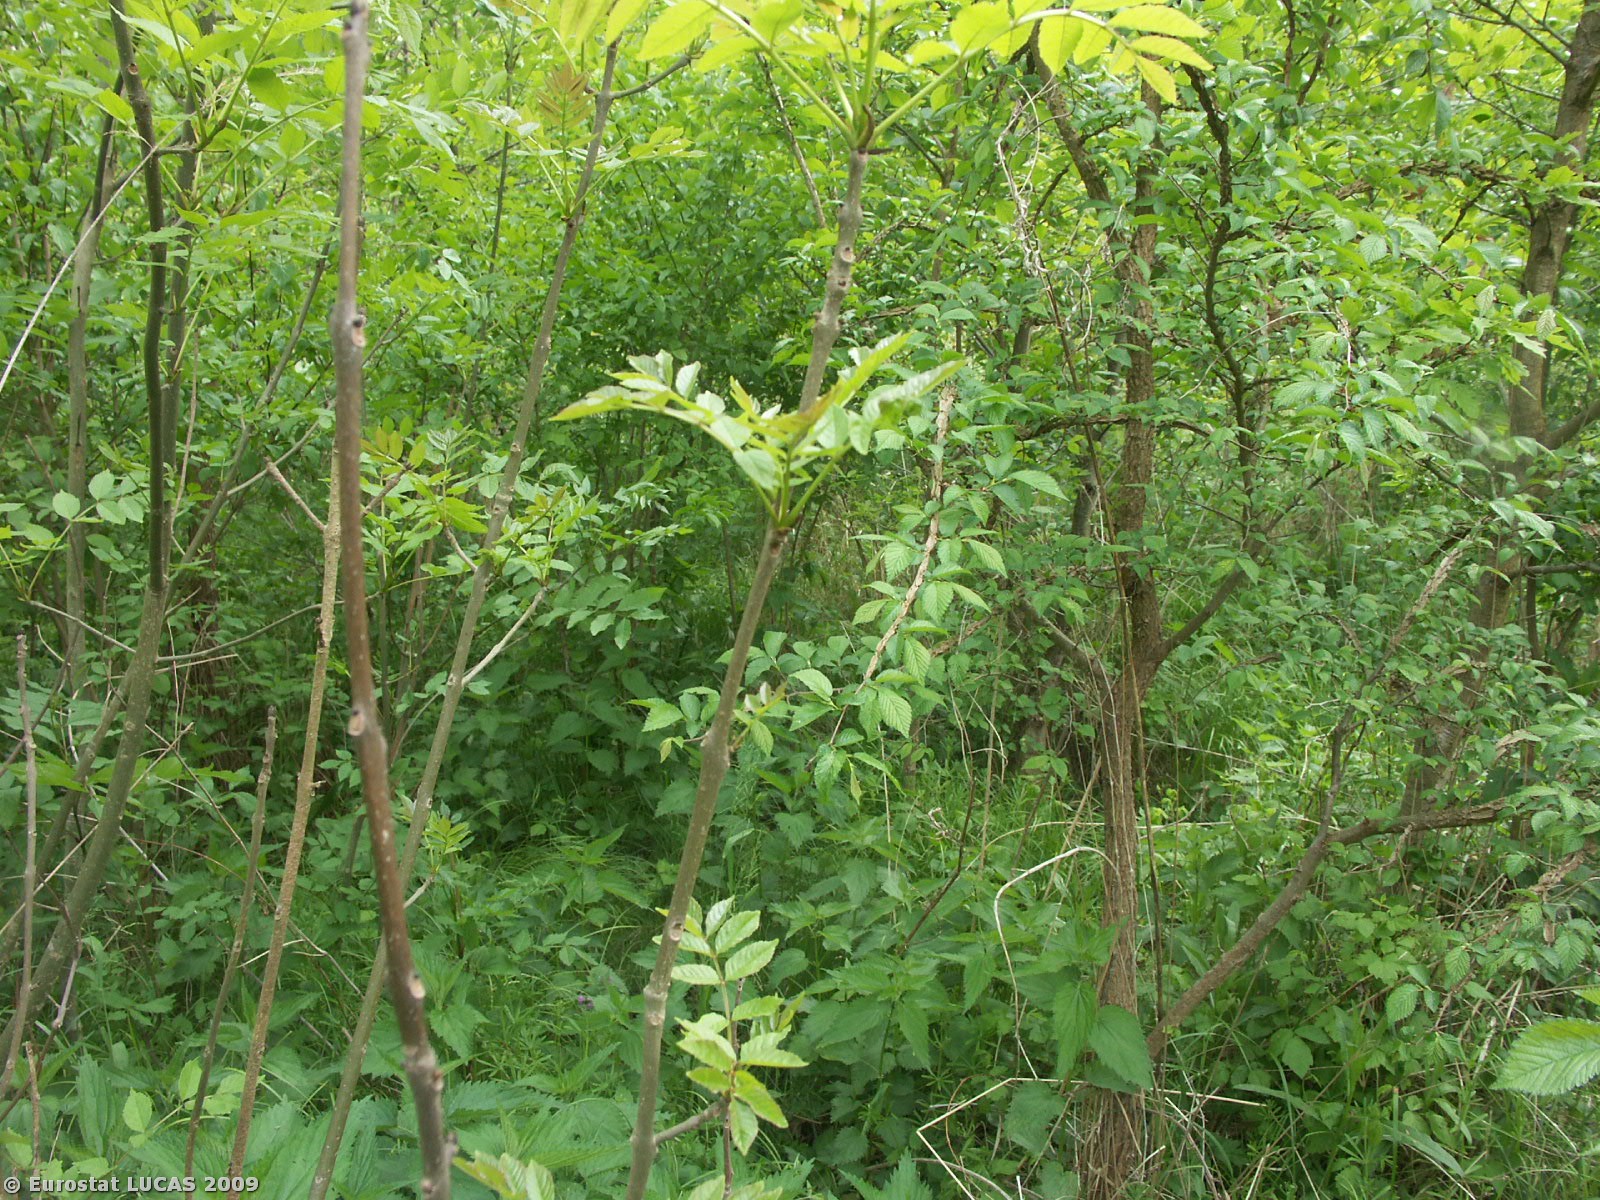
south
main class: Woodland
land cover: Broadleaved woodland
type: floodplain forest
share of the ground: > 75 %
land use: Forestry
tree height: > 5 m
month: May
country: CZ
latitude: 49.7068
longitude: 17.1517
